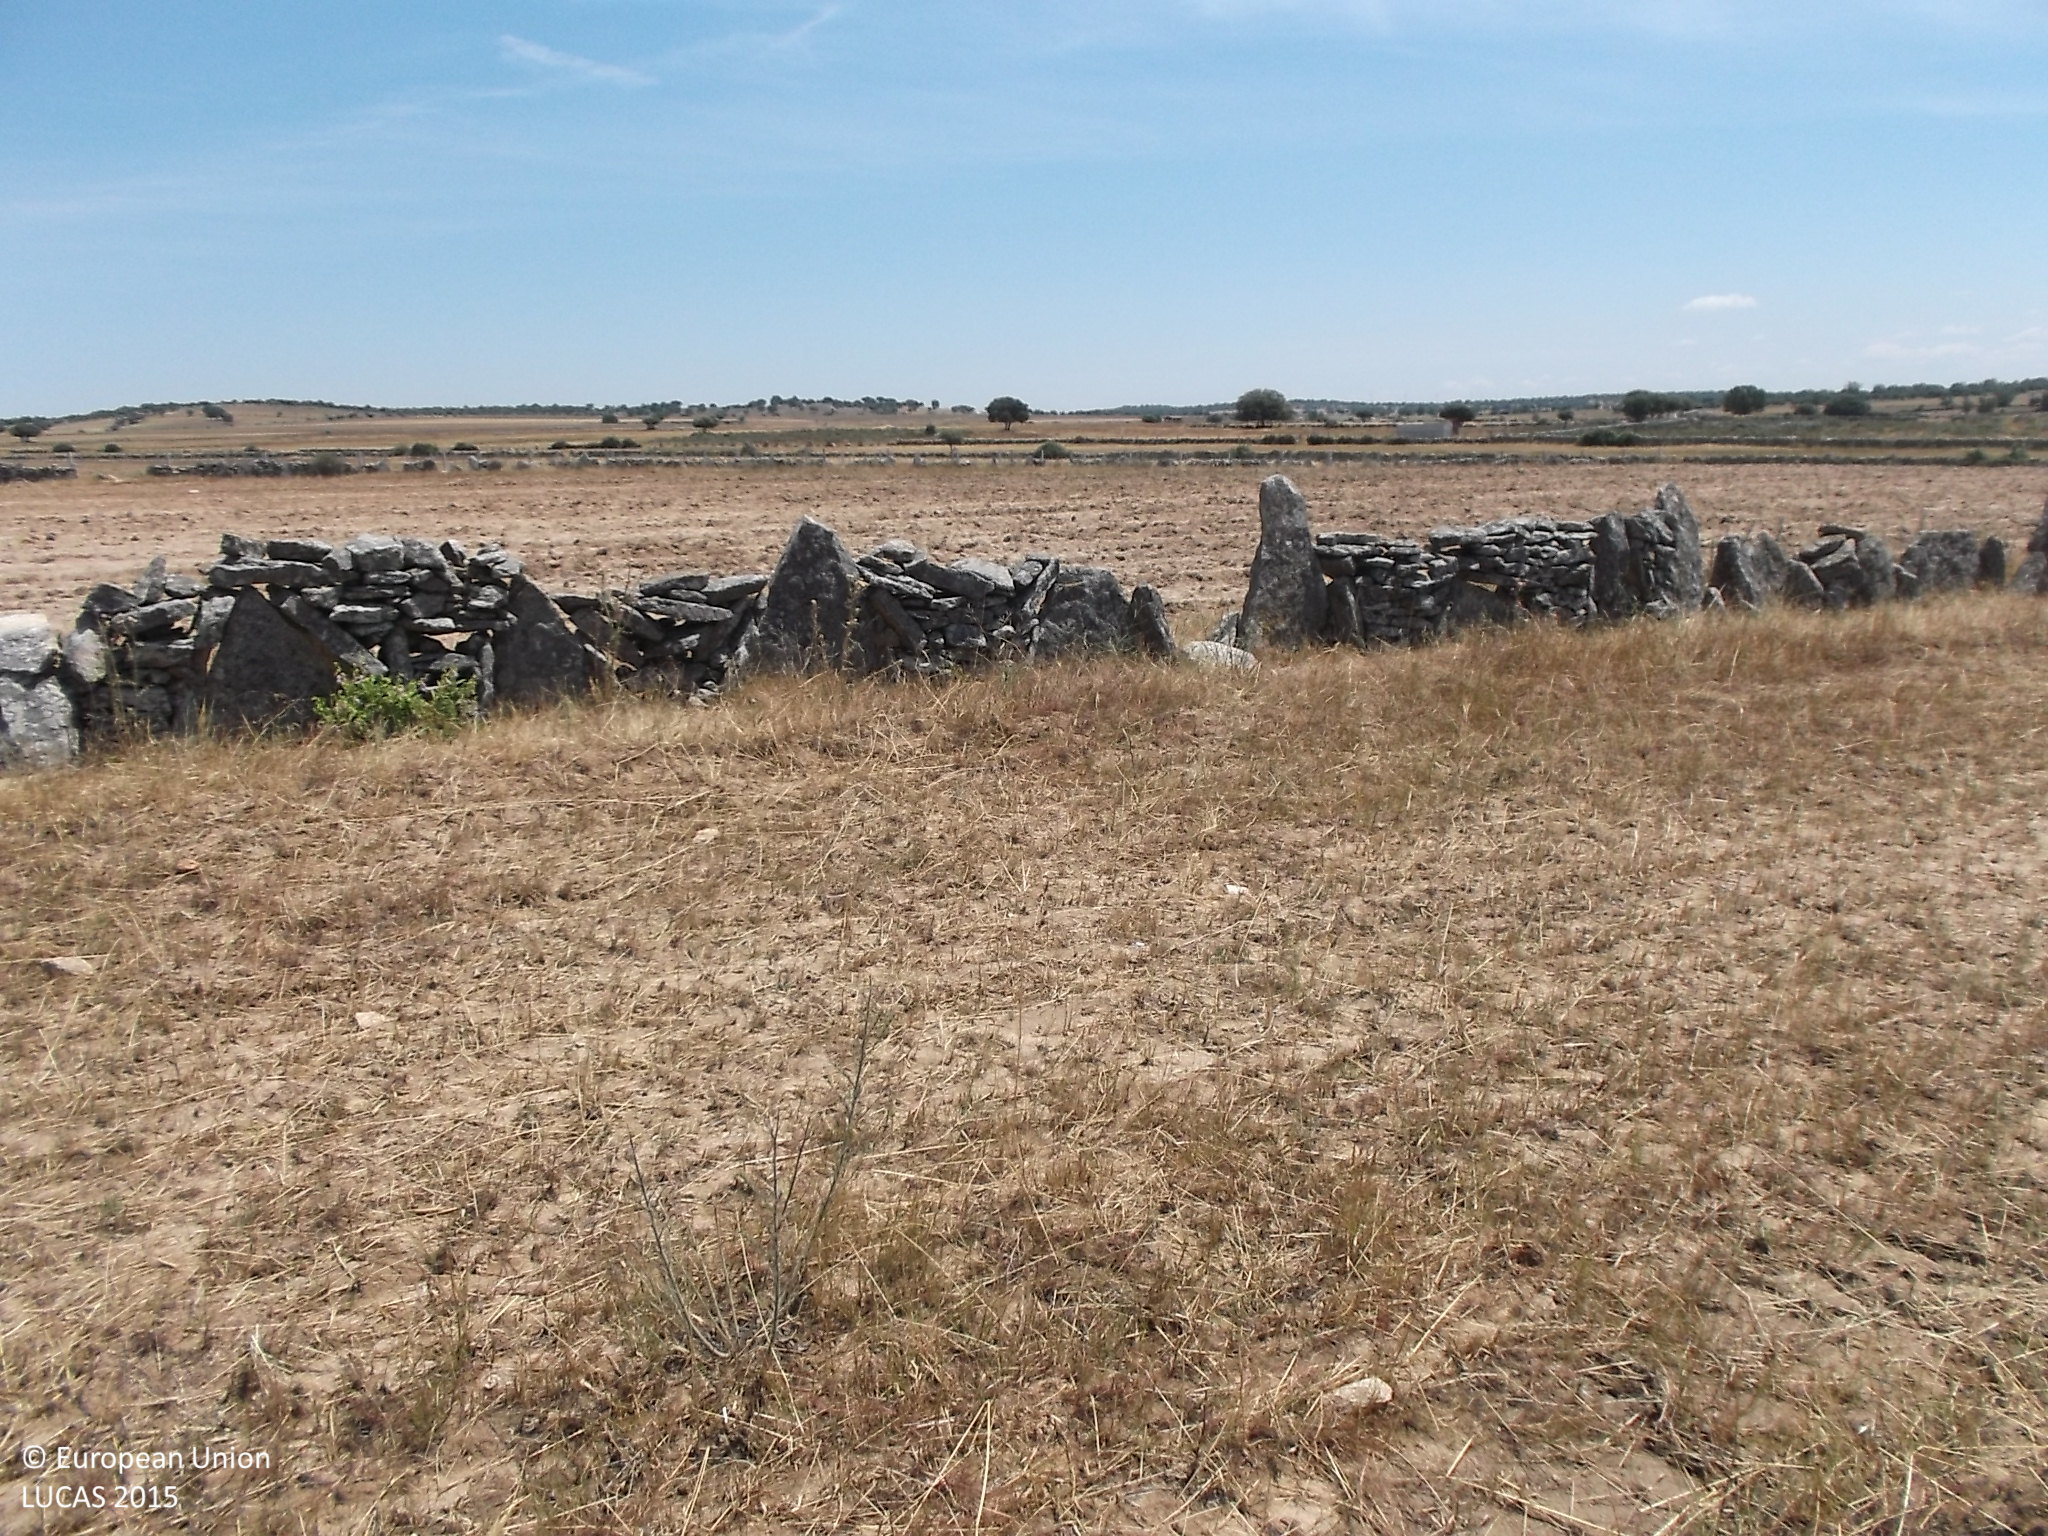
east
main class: Cropland
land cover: Rye
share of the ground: < 10 %
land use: Agriculture (excluding fallow land and kitchen gardens)
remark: Harvested field
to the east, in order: Rye; Grass margins; Dry stone walls; Grass margins; Other bare soil; Grass margins; Dry stone walls; Fences; Grassland without tree/shrub cover; Other bare soil; Grass margins; Fences; Grassland without tree/shrub cover; Dry stone walls; Grassland without tree/shrub cover
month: June
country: ES
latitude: 41.2547
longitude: -6.0457
